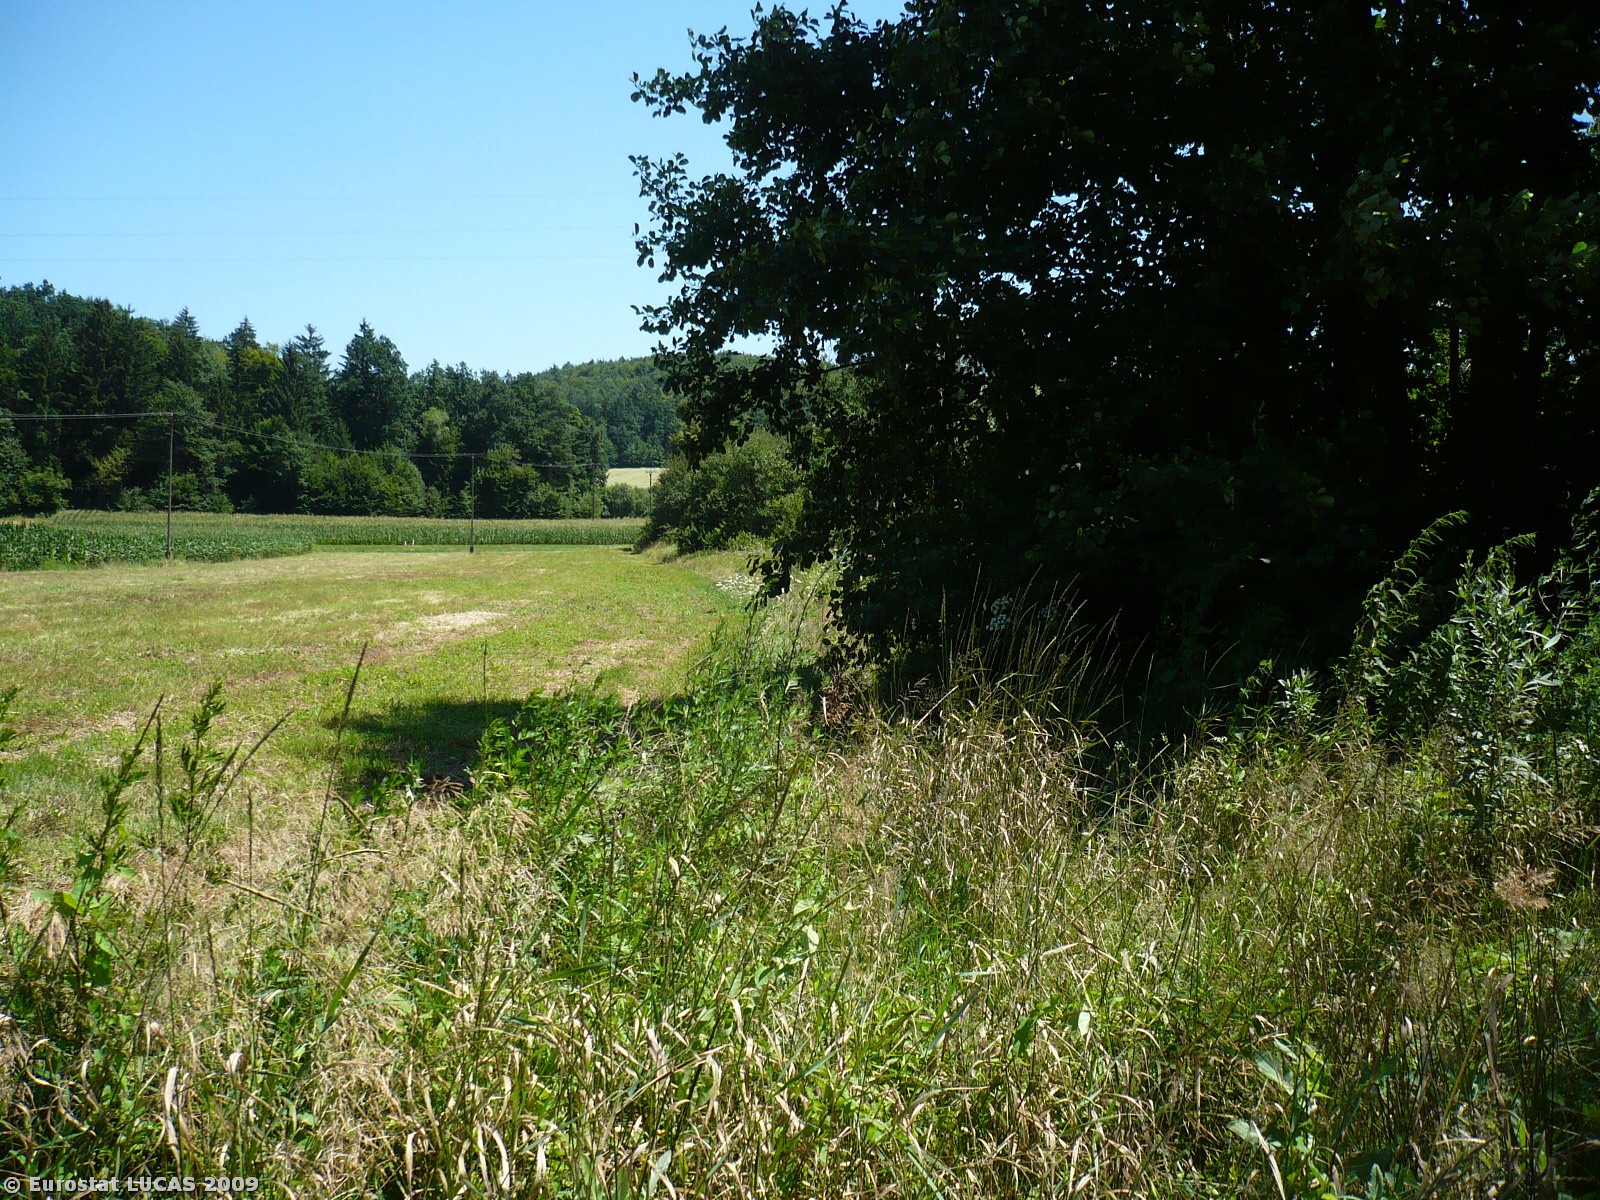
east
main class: Woodland
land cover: Broadleaved woodland
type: floodplain forest
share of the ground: > 75 %
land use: Unused
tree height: > 5 m
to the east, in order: Broadleaved woodland; Rivers and streams; Abandoned hedges; Grass margins; Paved roads, cycling and walking lanes; Grass margins; Maize
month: July
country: SI
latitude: 46.8109
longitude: 16.0684
